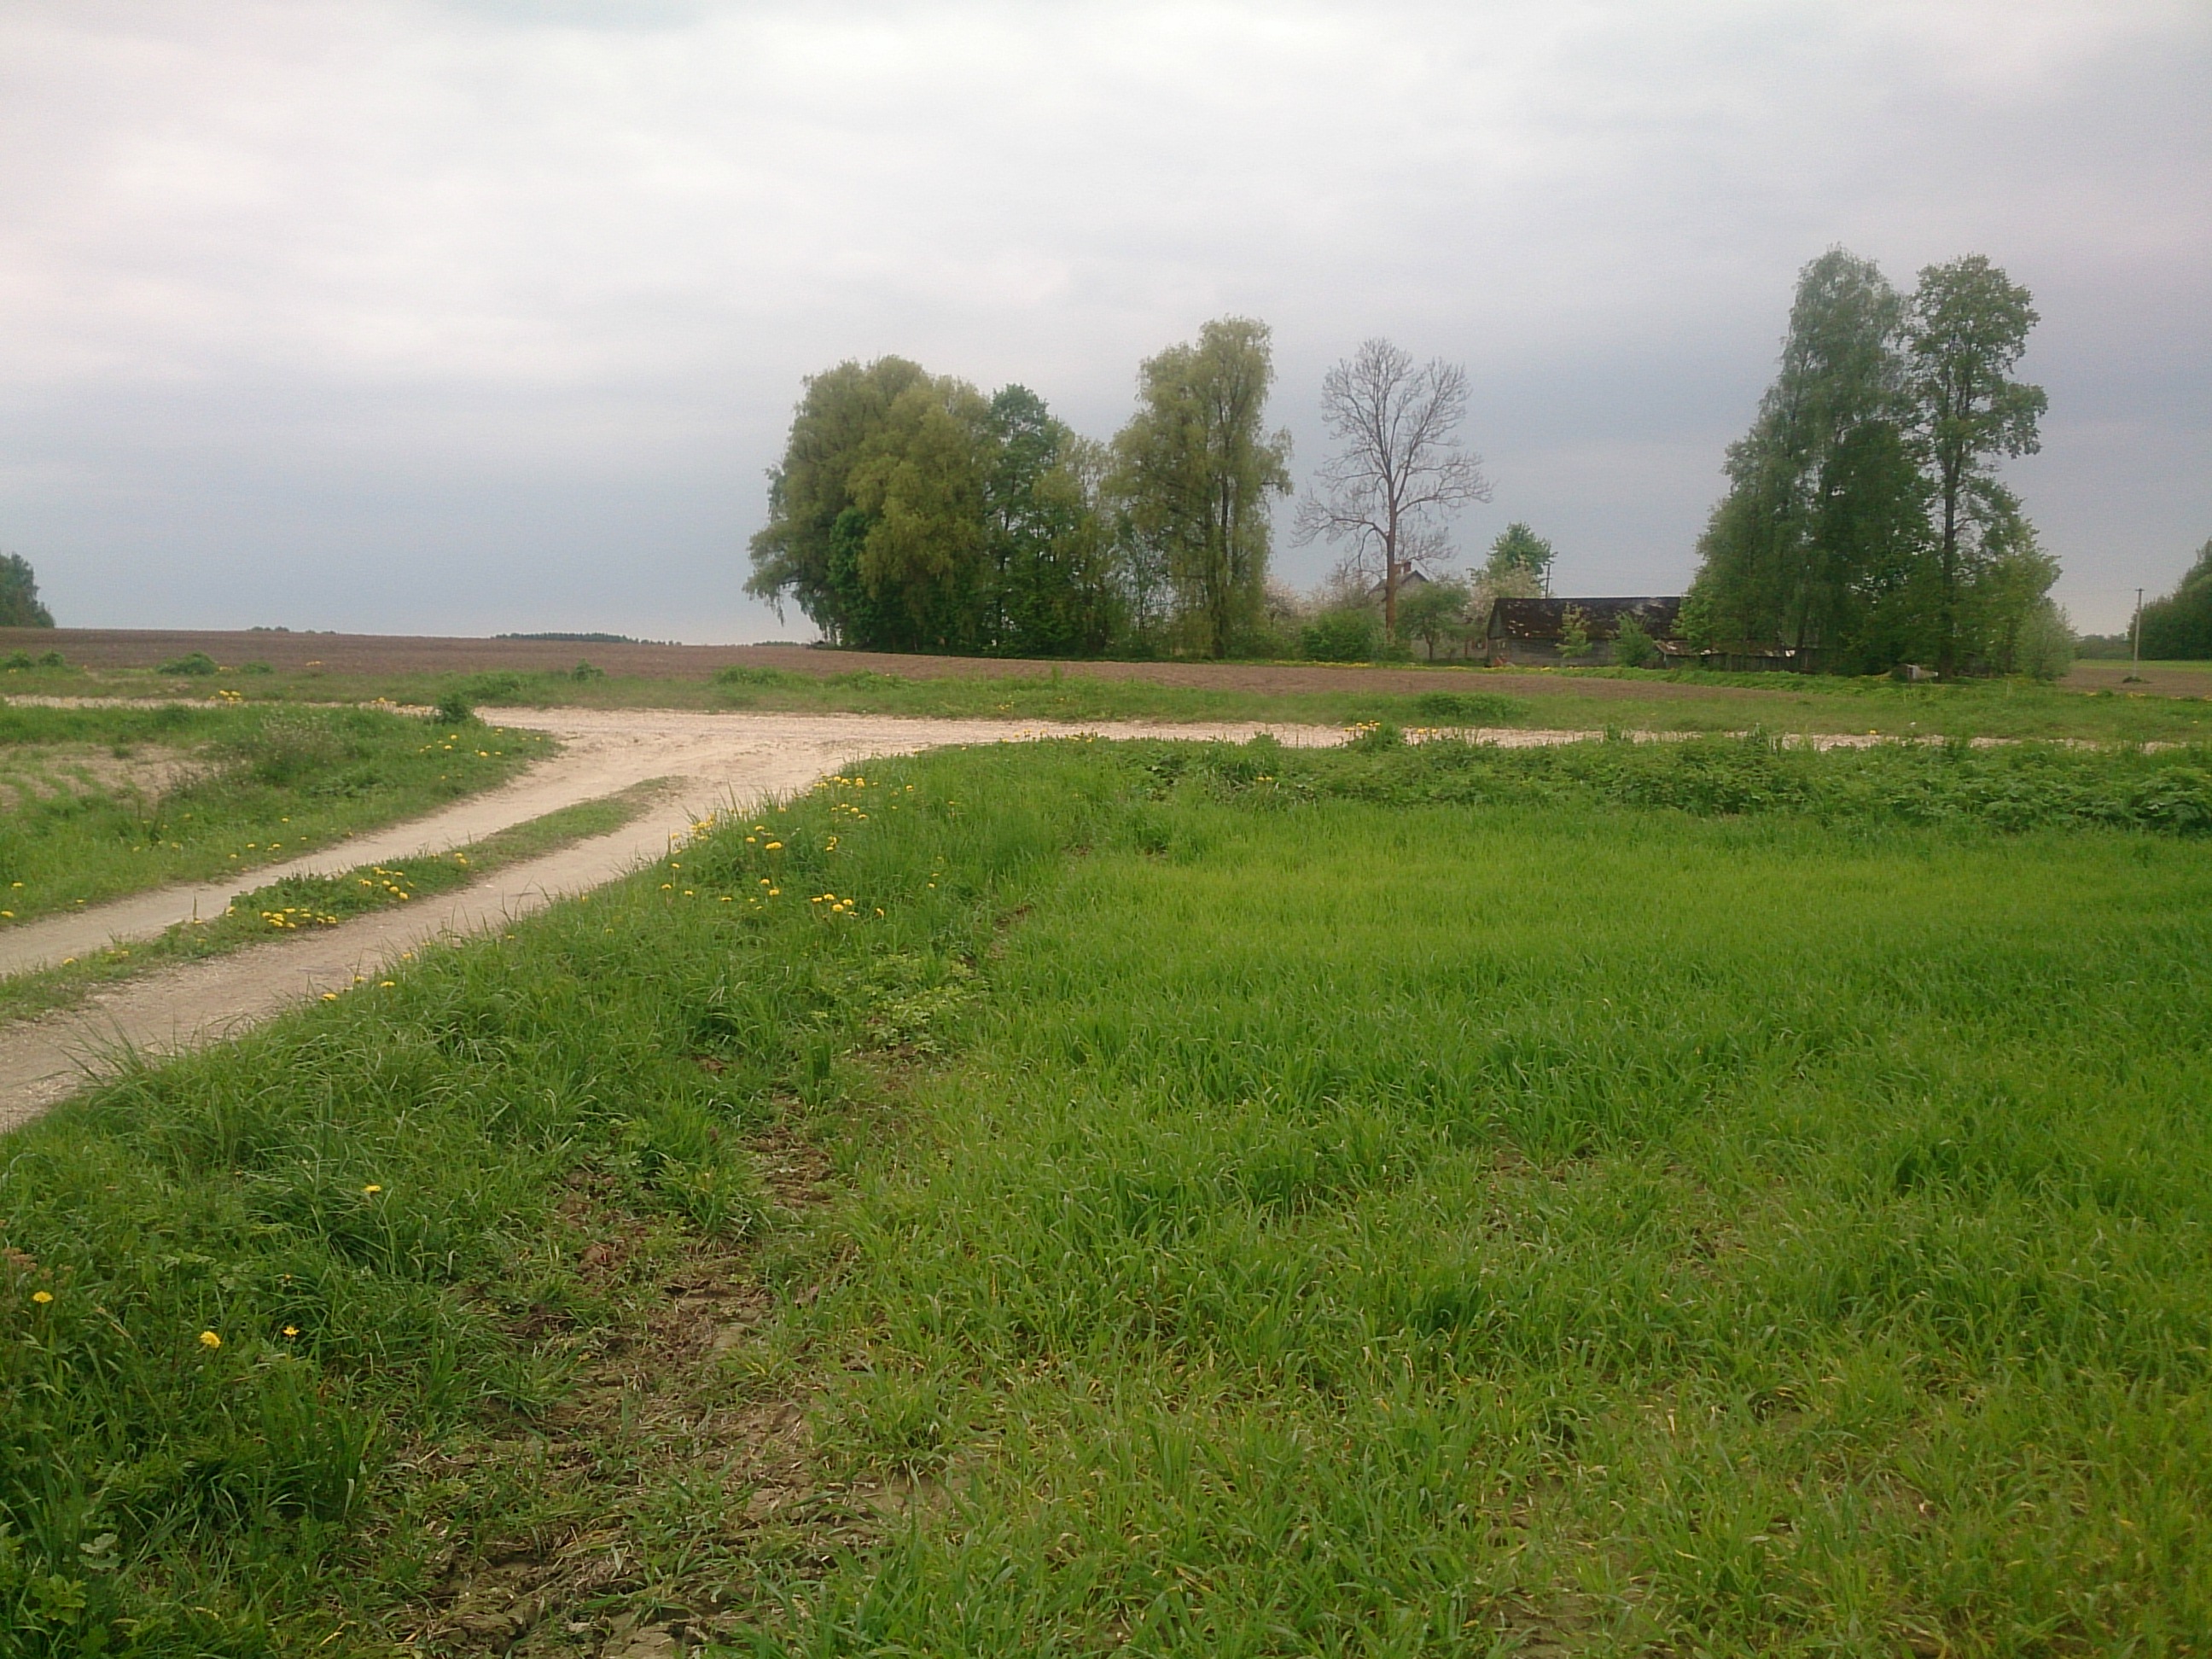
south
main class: Cropland
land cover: Common wheat
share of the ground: > 75 %
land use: Agriculture (excluding fallow land and kitchen gardens)
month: May
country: LV
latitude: 56.5003
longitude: 24.1072
